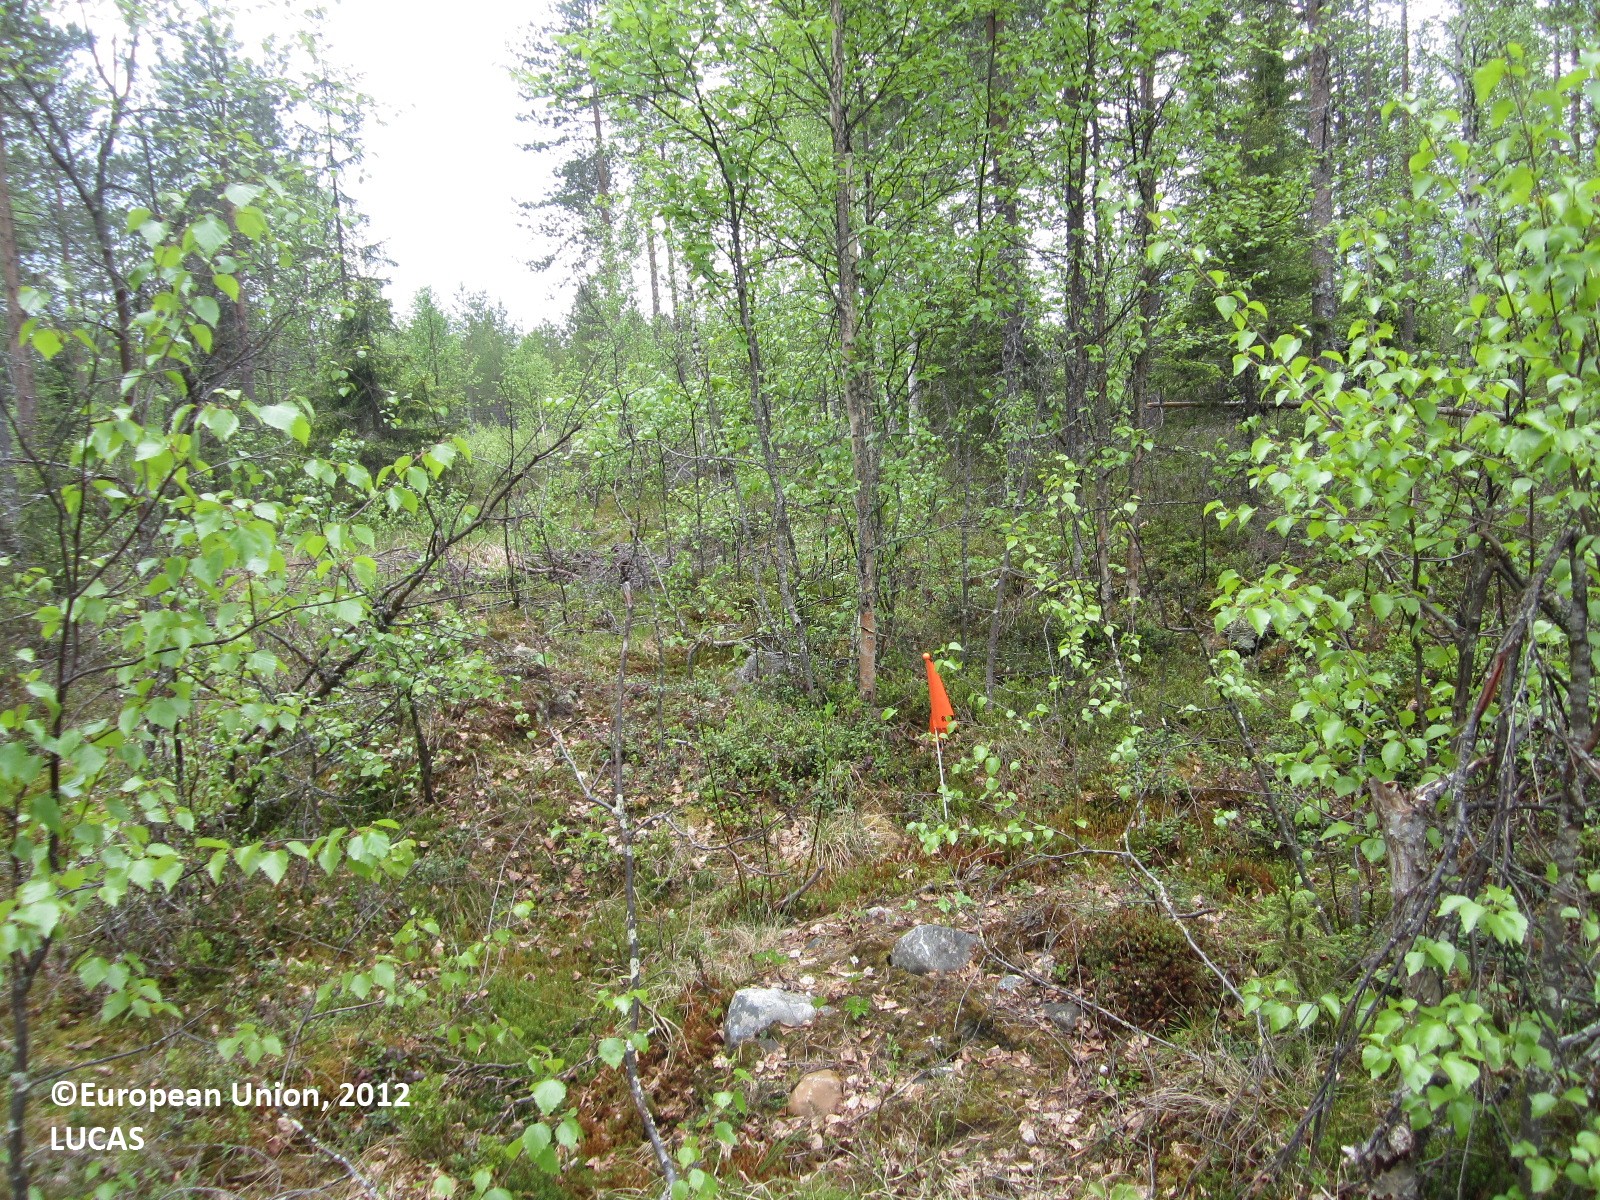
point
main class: Woodland
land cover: Pine dominated mixed woodland
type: boreal forest
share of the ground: 25 - 50 %
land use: Forestry
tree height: > 5 m
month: June
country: FI
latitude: 64.5480
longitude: 28.6370
